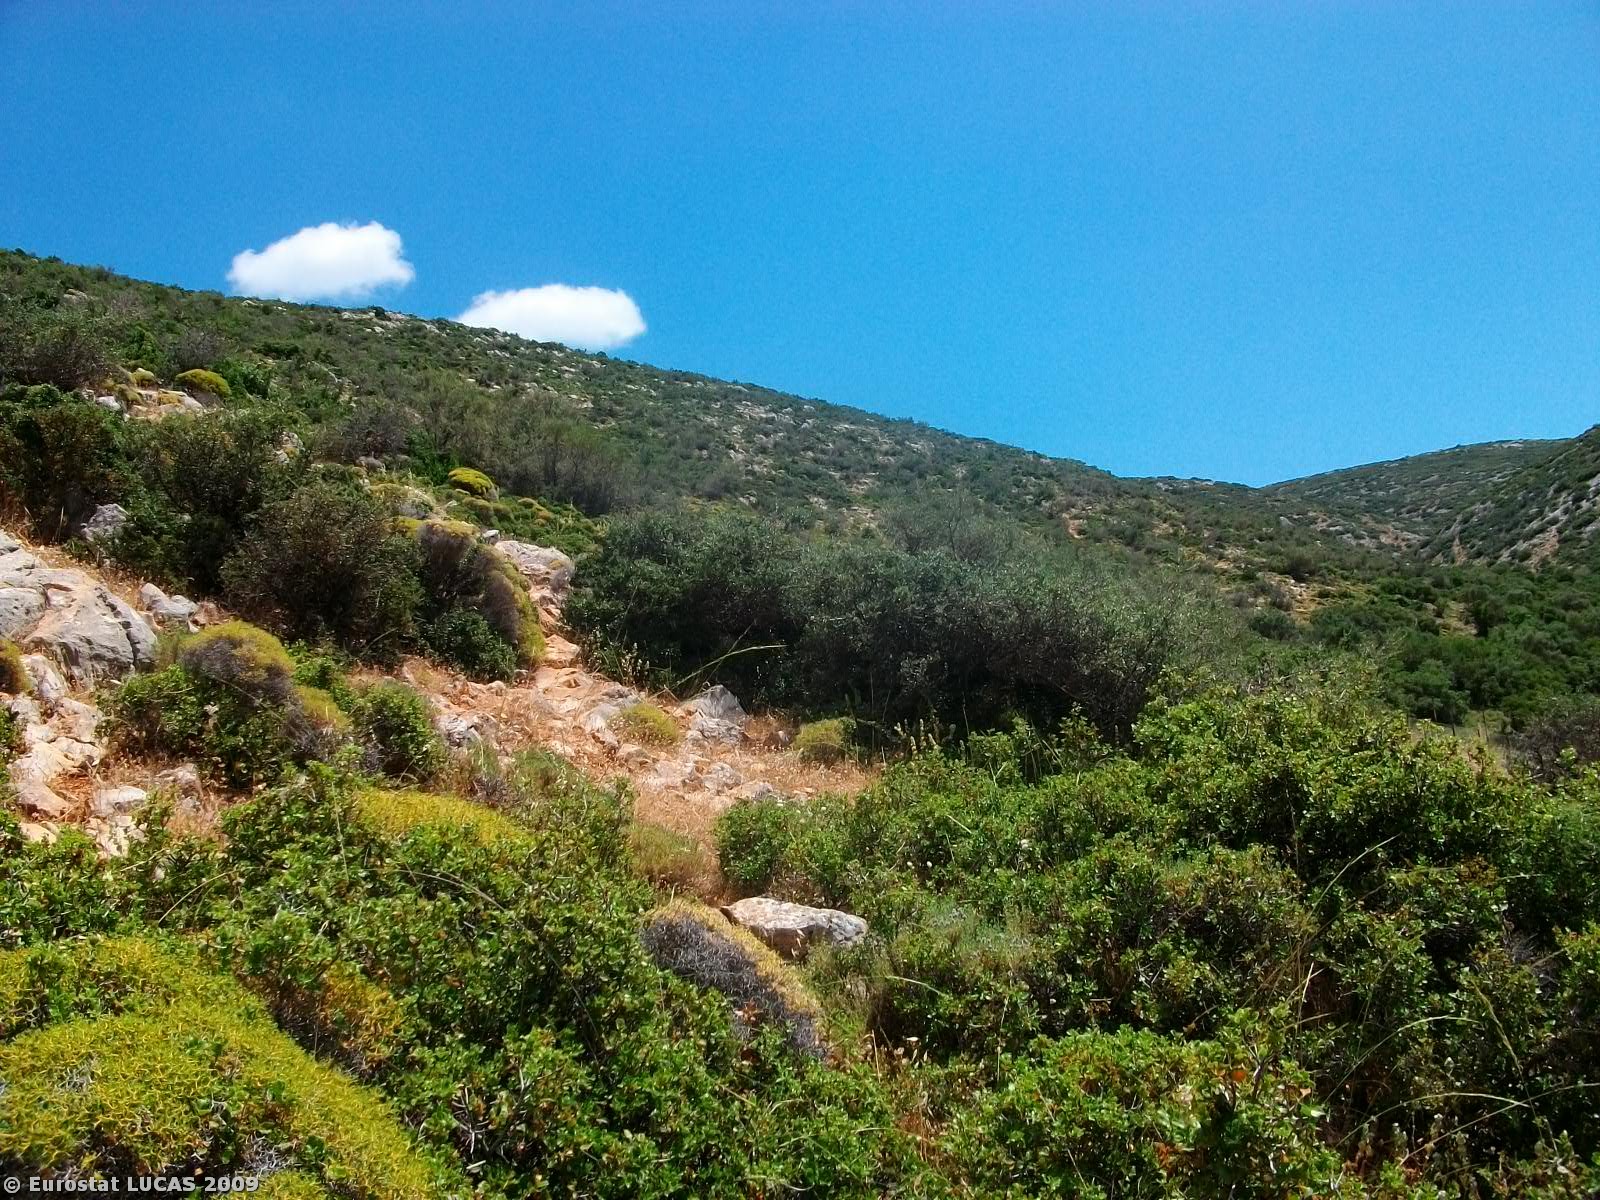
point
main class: Shrubland
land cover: Shrubland without tree cover
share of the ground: > 75 %
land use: Agriculture (excluding fallow land and kitchen gardens)
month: June
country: GR
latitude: 38.2365
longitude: 23.0588
